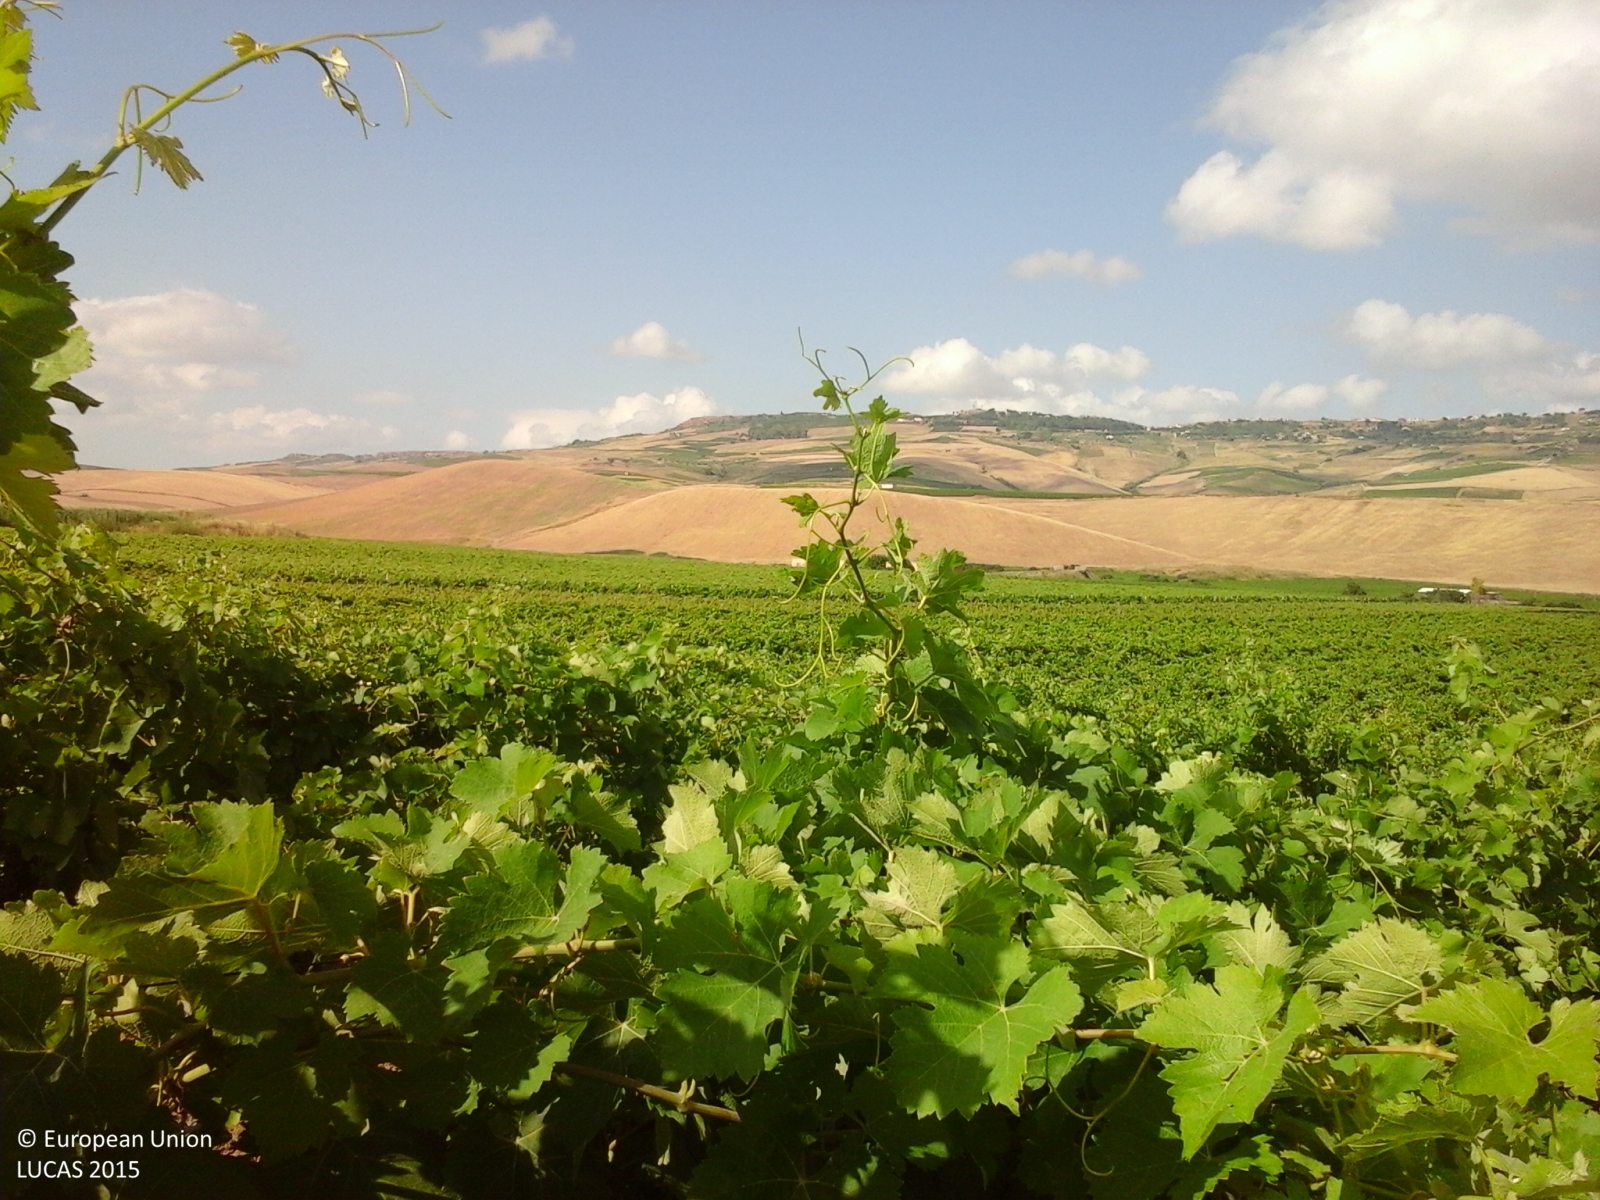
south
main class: Cropland
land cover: Vineyards
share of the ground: 50 - 75 %
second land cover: Other bare soil
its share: > 75 %
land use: Agriculture (excluding fallow land and kitchen gardens)
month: June
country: IT
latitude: 37.7168
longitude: 13.0515
